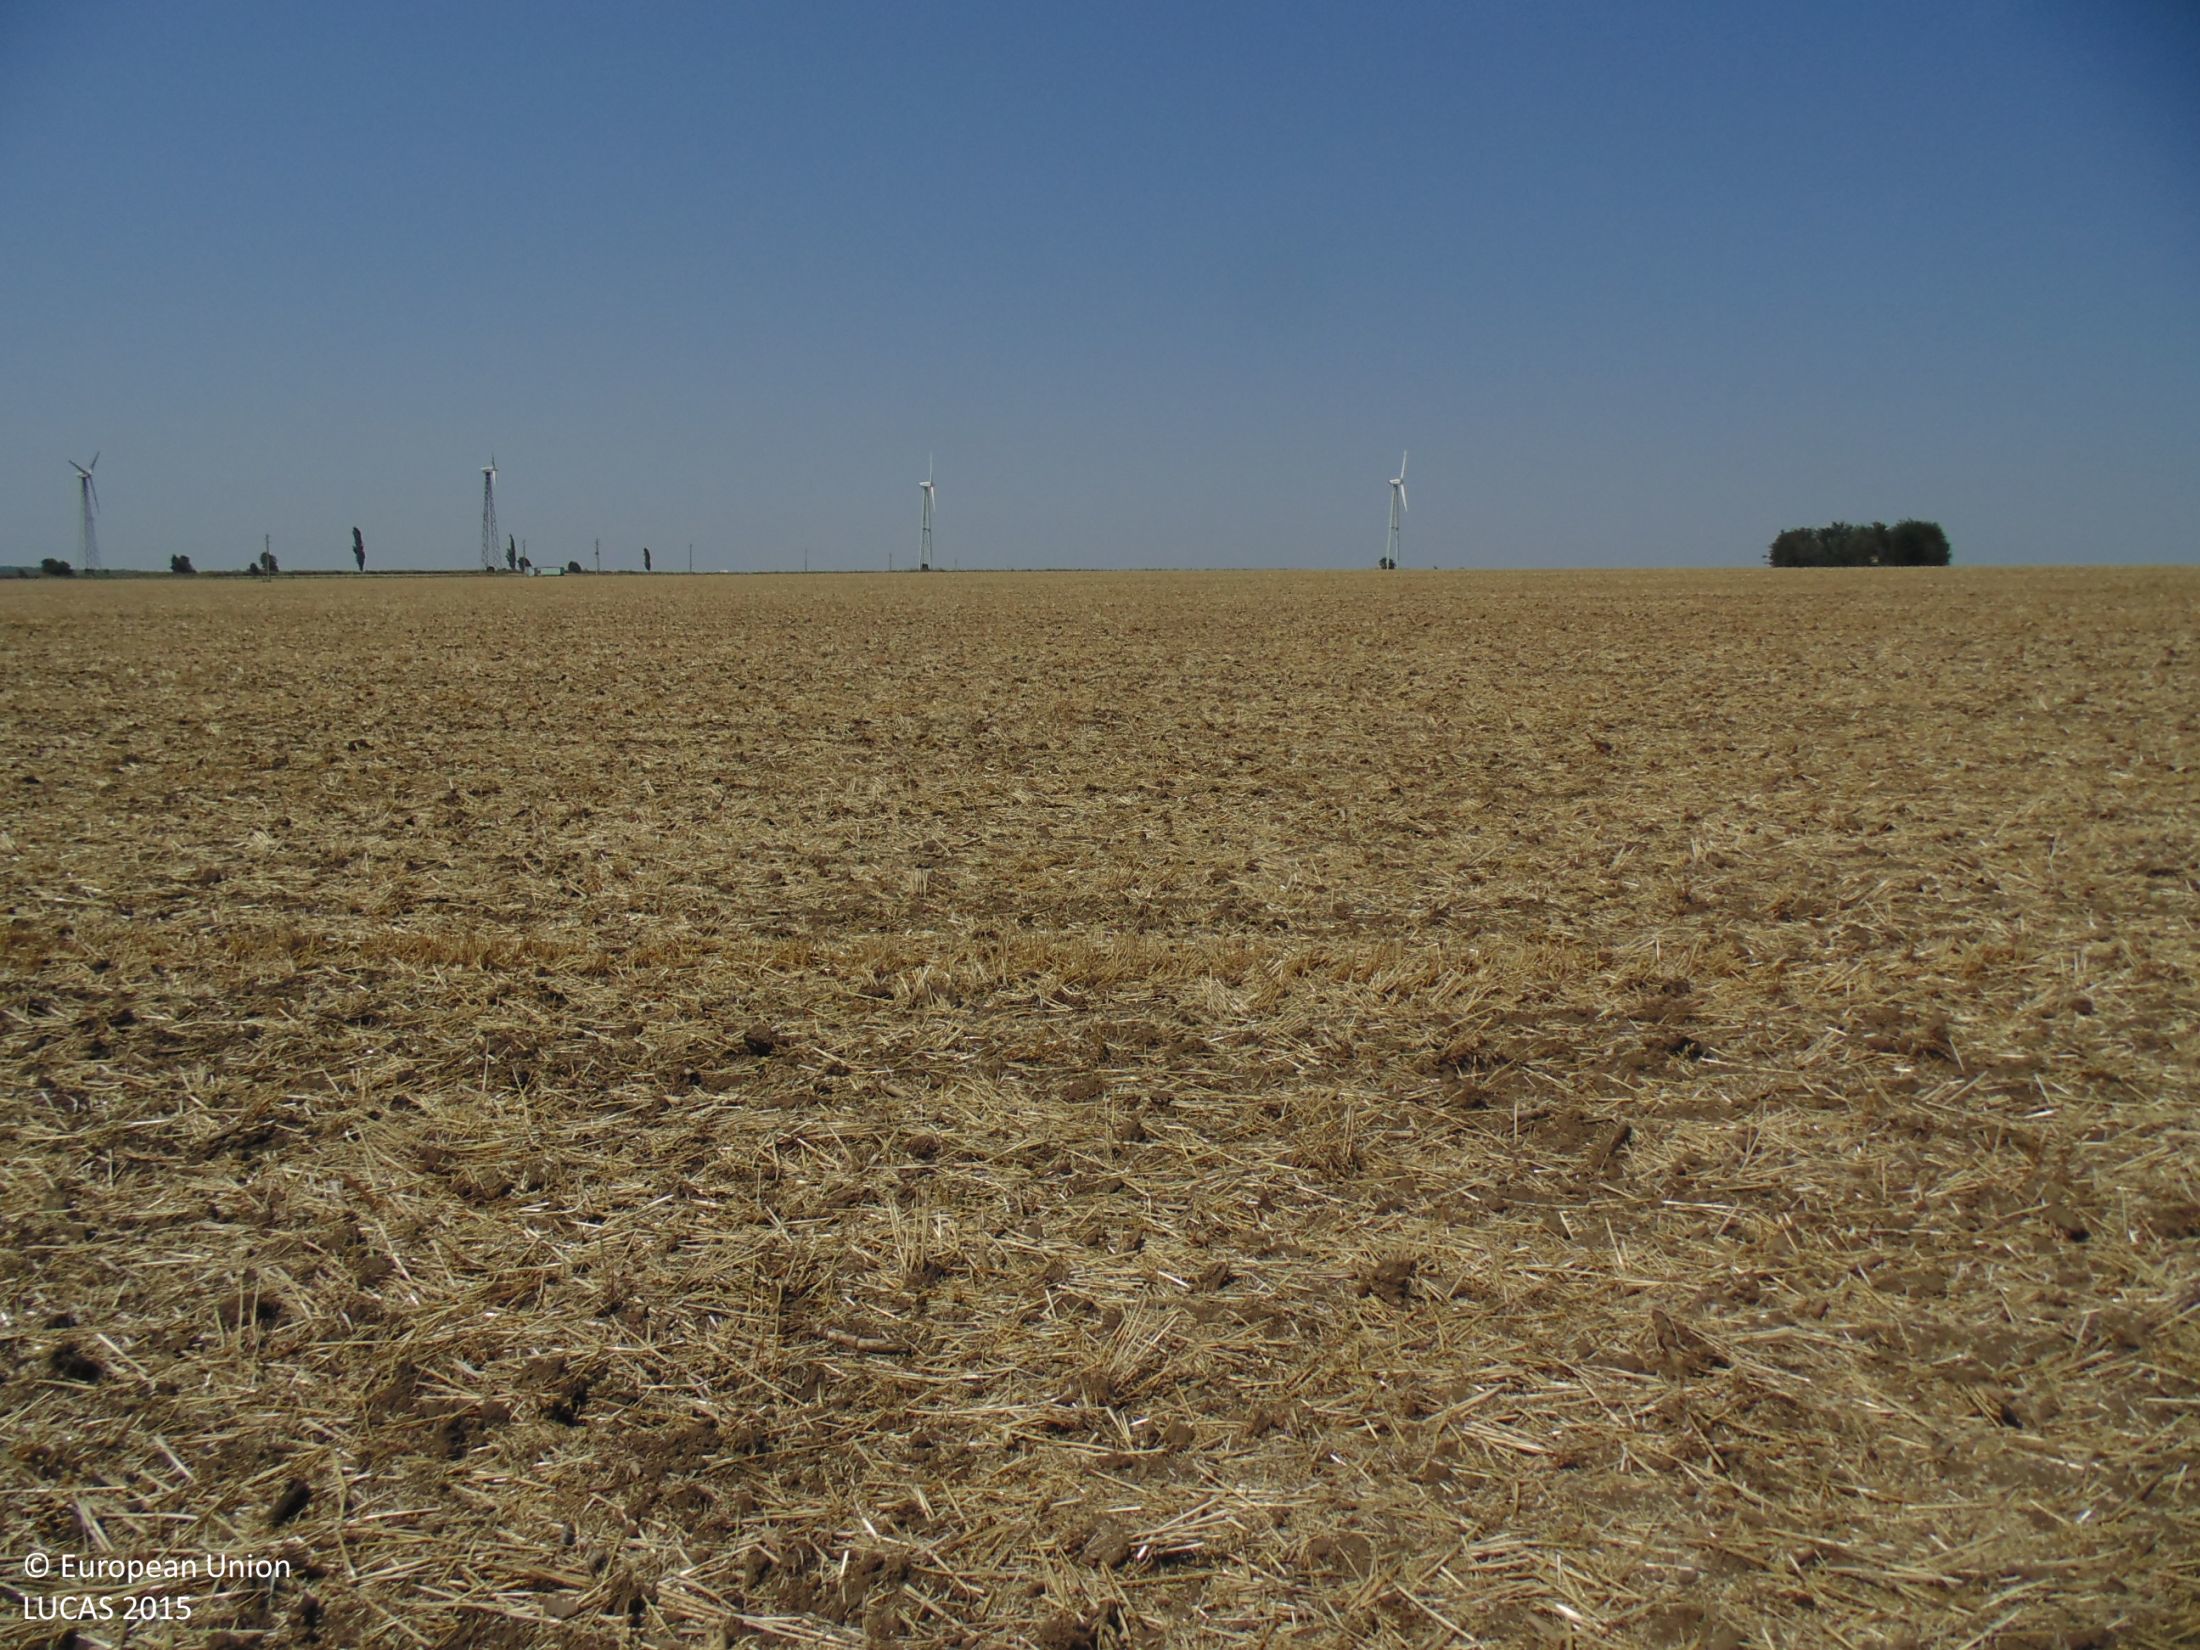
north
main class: Cropland
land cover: Common wheat
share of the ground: < 10 %
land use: Agriculture (excluding fallow land and kitchen gardens)
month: August
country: BG
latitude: 43.6919
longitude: 28.3600
